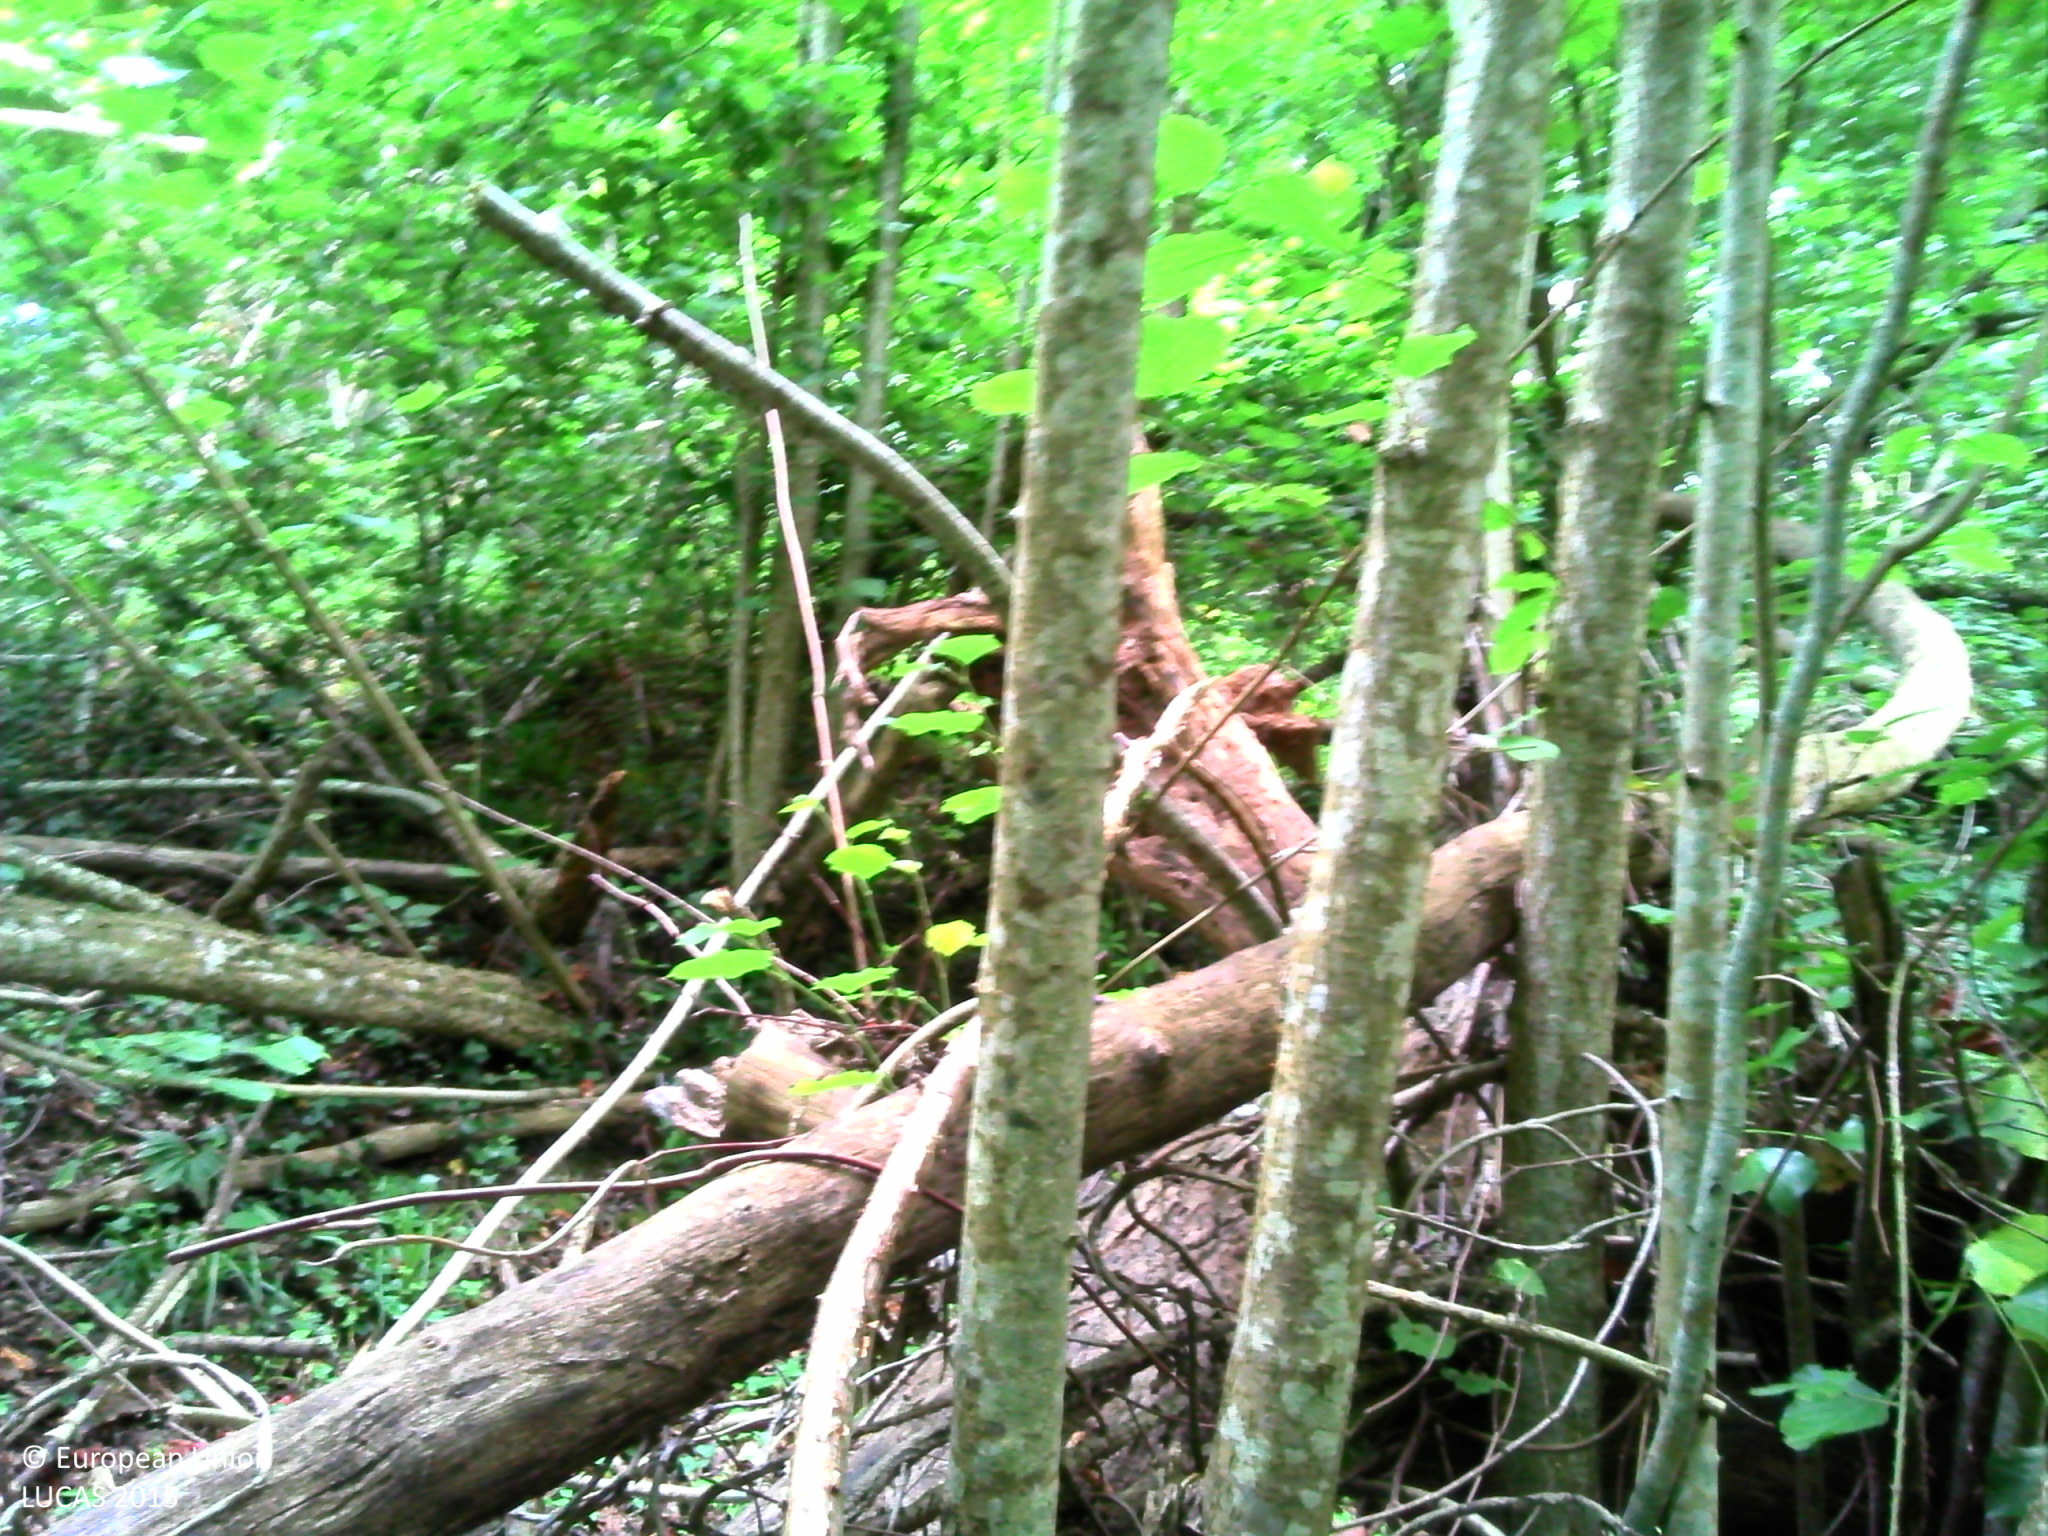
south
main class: Woodland
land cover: Broadleaved woodland
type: mesophytic deciduous forest
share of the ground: > 75 %
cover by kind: broadleaved forest trees 90 %, shrubs 5 %, herbaceous plants 5 %
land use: Forestry
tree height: > 5 m
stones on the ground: 10 - 25 %
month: July
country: FR
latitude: 42.9823
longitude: -0.1198
